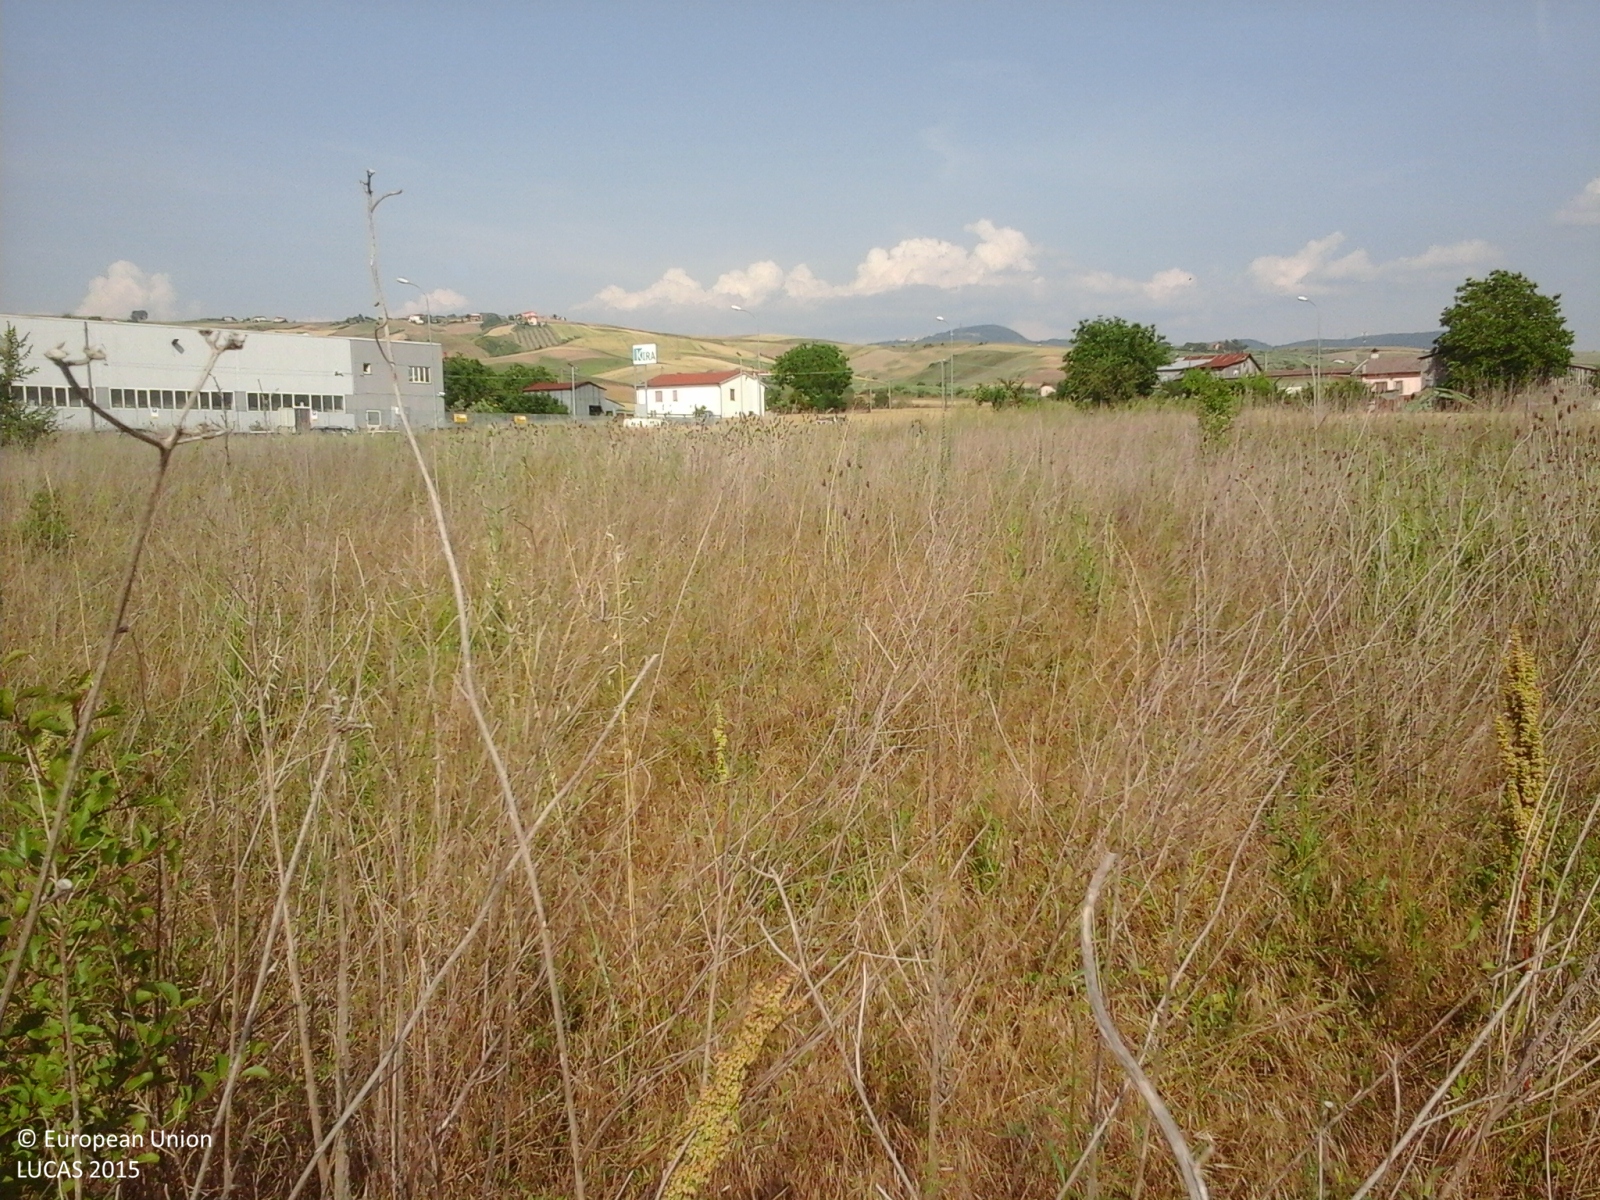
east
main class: Grassland
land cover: Grassland without tree/shrub cover
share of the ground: > 75 %
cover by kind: herbaceous plants 100 %
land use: Abandoned areas
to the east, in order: Grassland without tree/shrub cover; Common wheat; Artificial constructions in urban areas; Durum wheat; Artificial constructions in urban areas; Maize; Electric lines; Ditches and canals; Paved roads, cycling and walking lanes; Grass margins; Common wheat
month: June
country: IT
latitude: 41.0573
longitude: 15.1330
